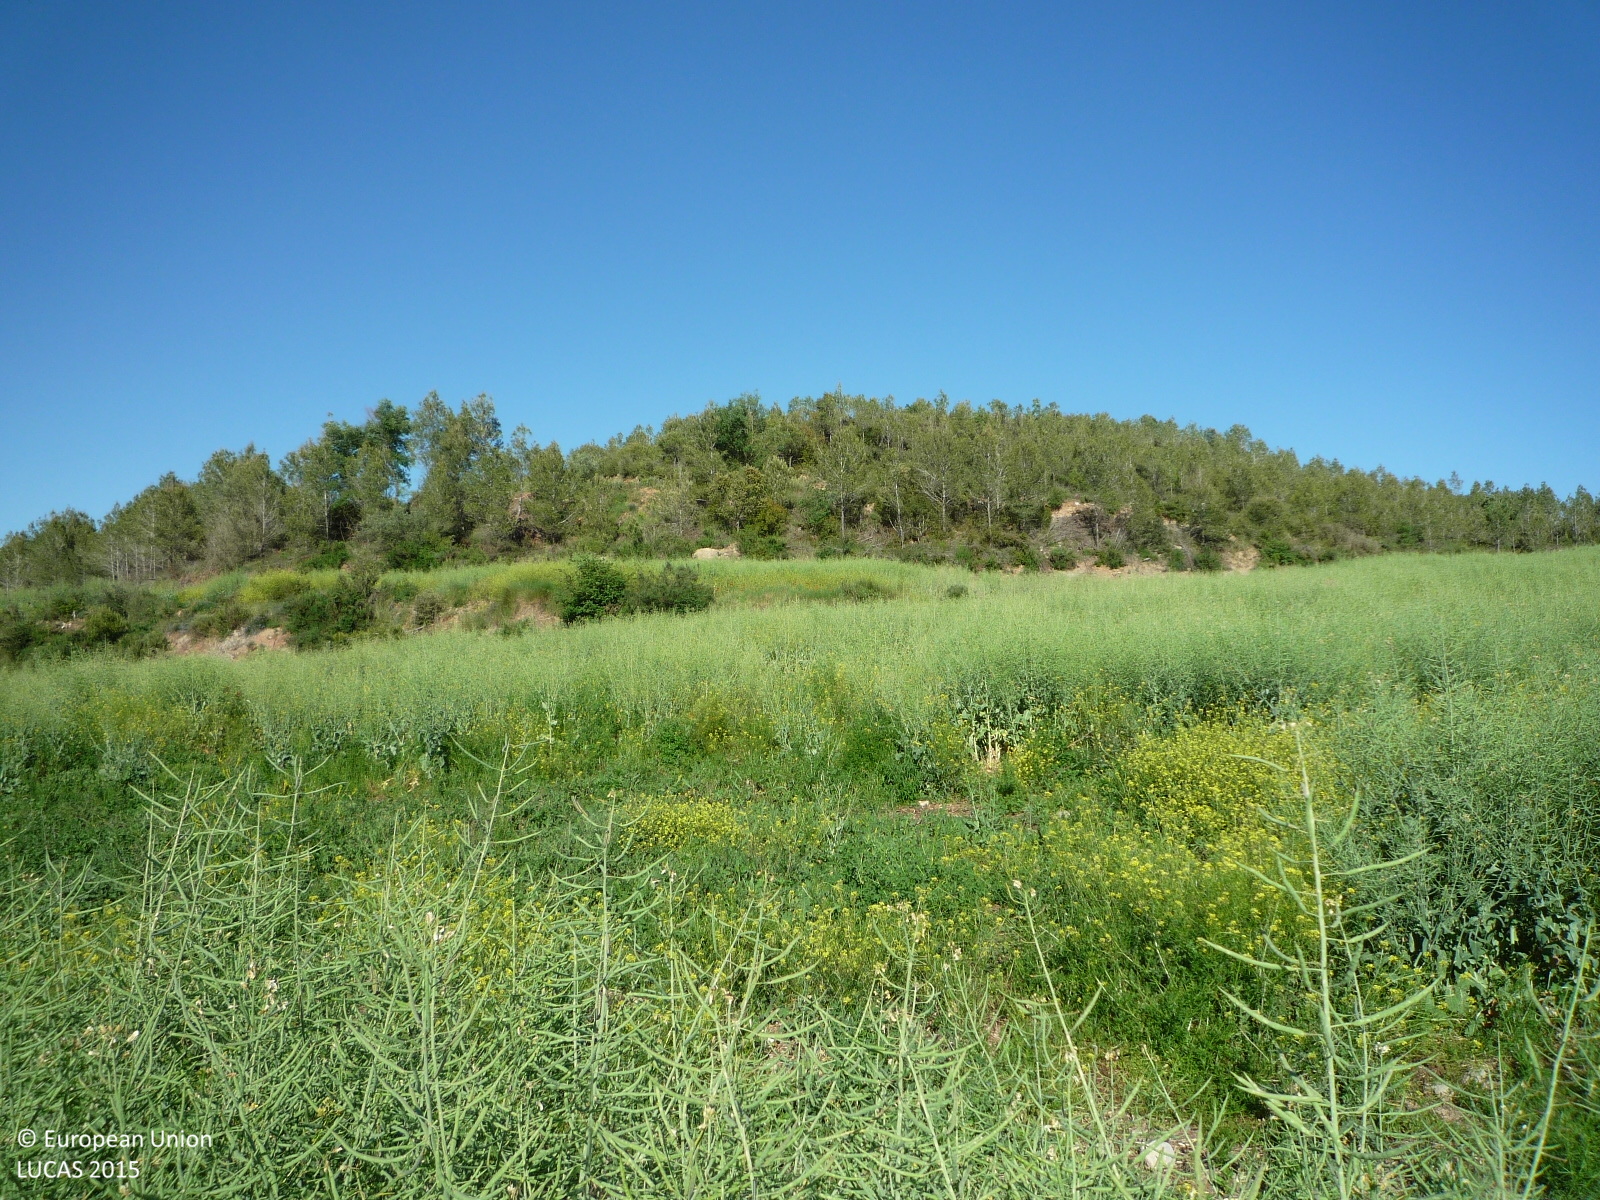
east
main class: Cropland
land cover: Rape and turnip rape
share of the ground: > 75 %
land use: Agriculture (excluding fallow land and kitchen gardens)
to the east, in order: Rape and turnip rape; Dry stone walls; Rape and turnip rape; Shrubland with sparse tree cover; Tracks; Pine dominated coniferous woodland; Dry stone walls; Rape and turnip rape; Pine dominated coniferous woodland; Grass margins; Tracks; Pine dominated coniferous woodland; Rape and turnip rape
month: May
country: ES
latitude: 41.7905
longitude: 1.7476
